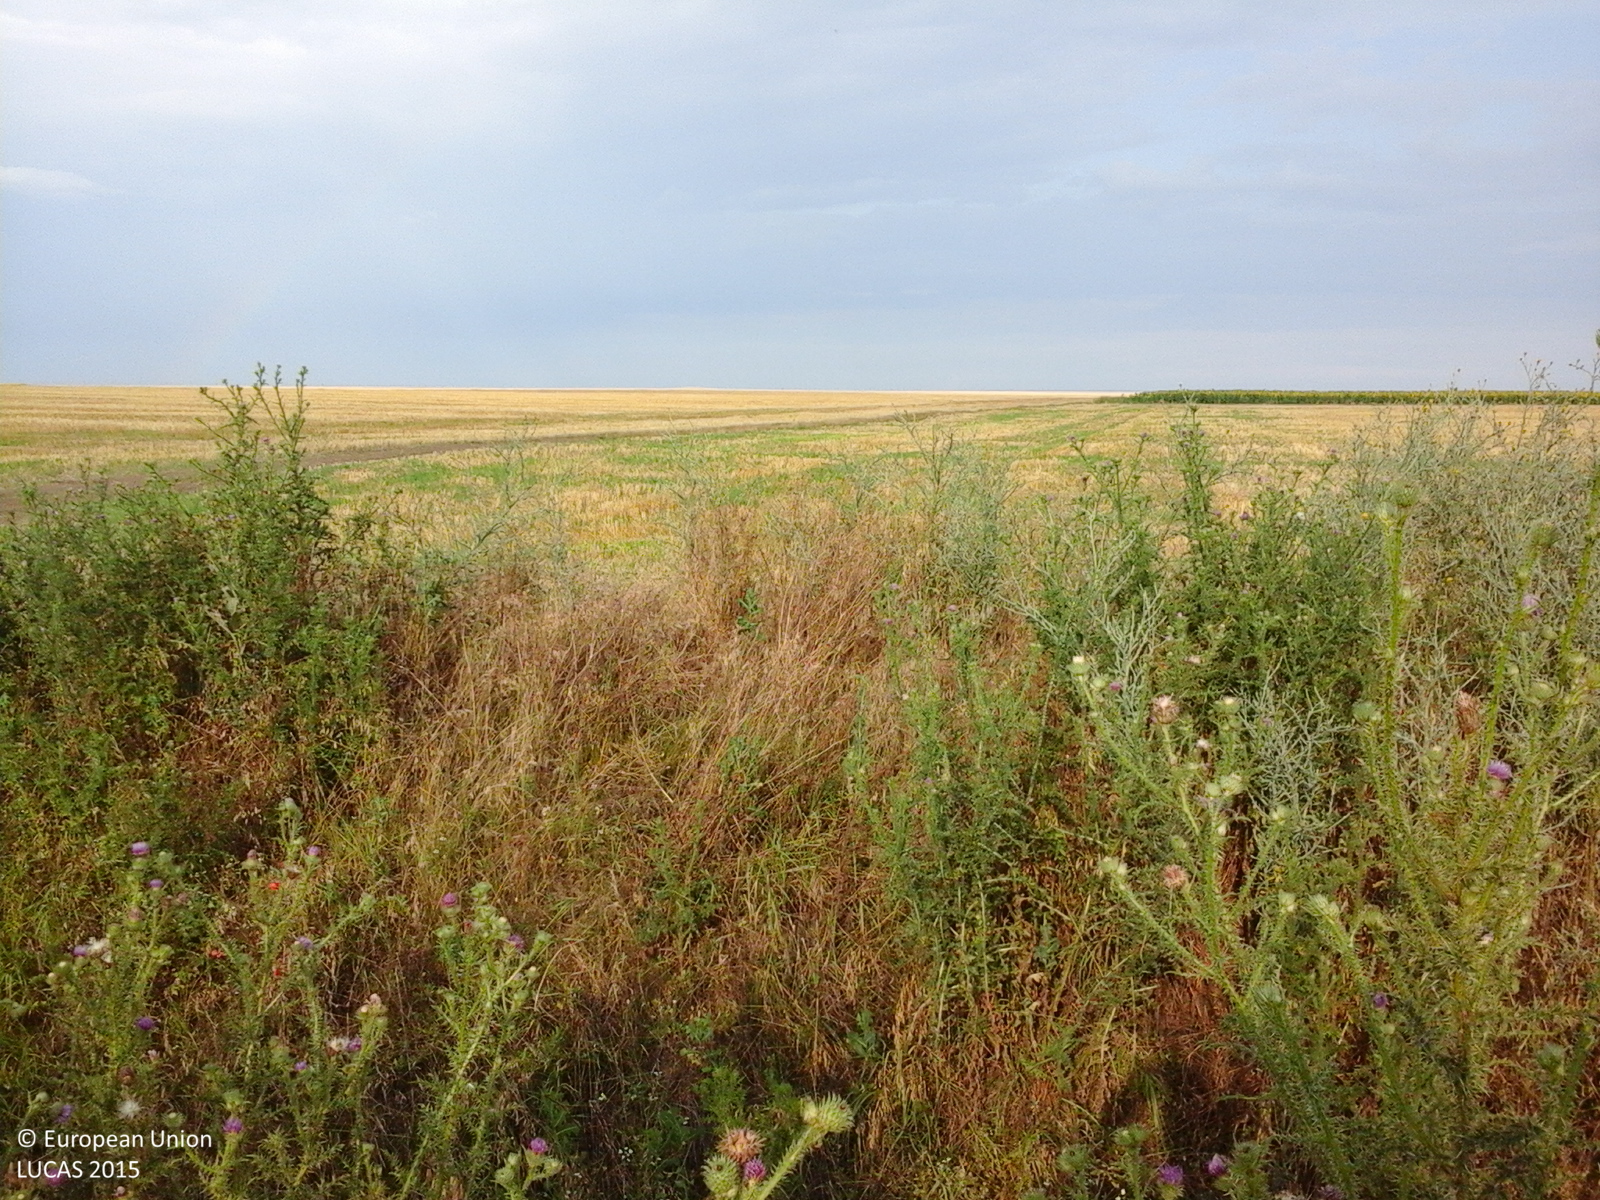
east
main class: Cropland
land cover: Common wheat
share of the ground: > 75 %
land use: Agriculture (excluding fallow land and kitchen gardens)
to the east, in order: Common wheat; Shruby margins; Ditches and canals; Shruby margins; Tracks; Common wheat; Tracks; Common wheat
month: July
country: RO
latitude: 43.9152
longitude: 24.4735
